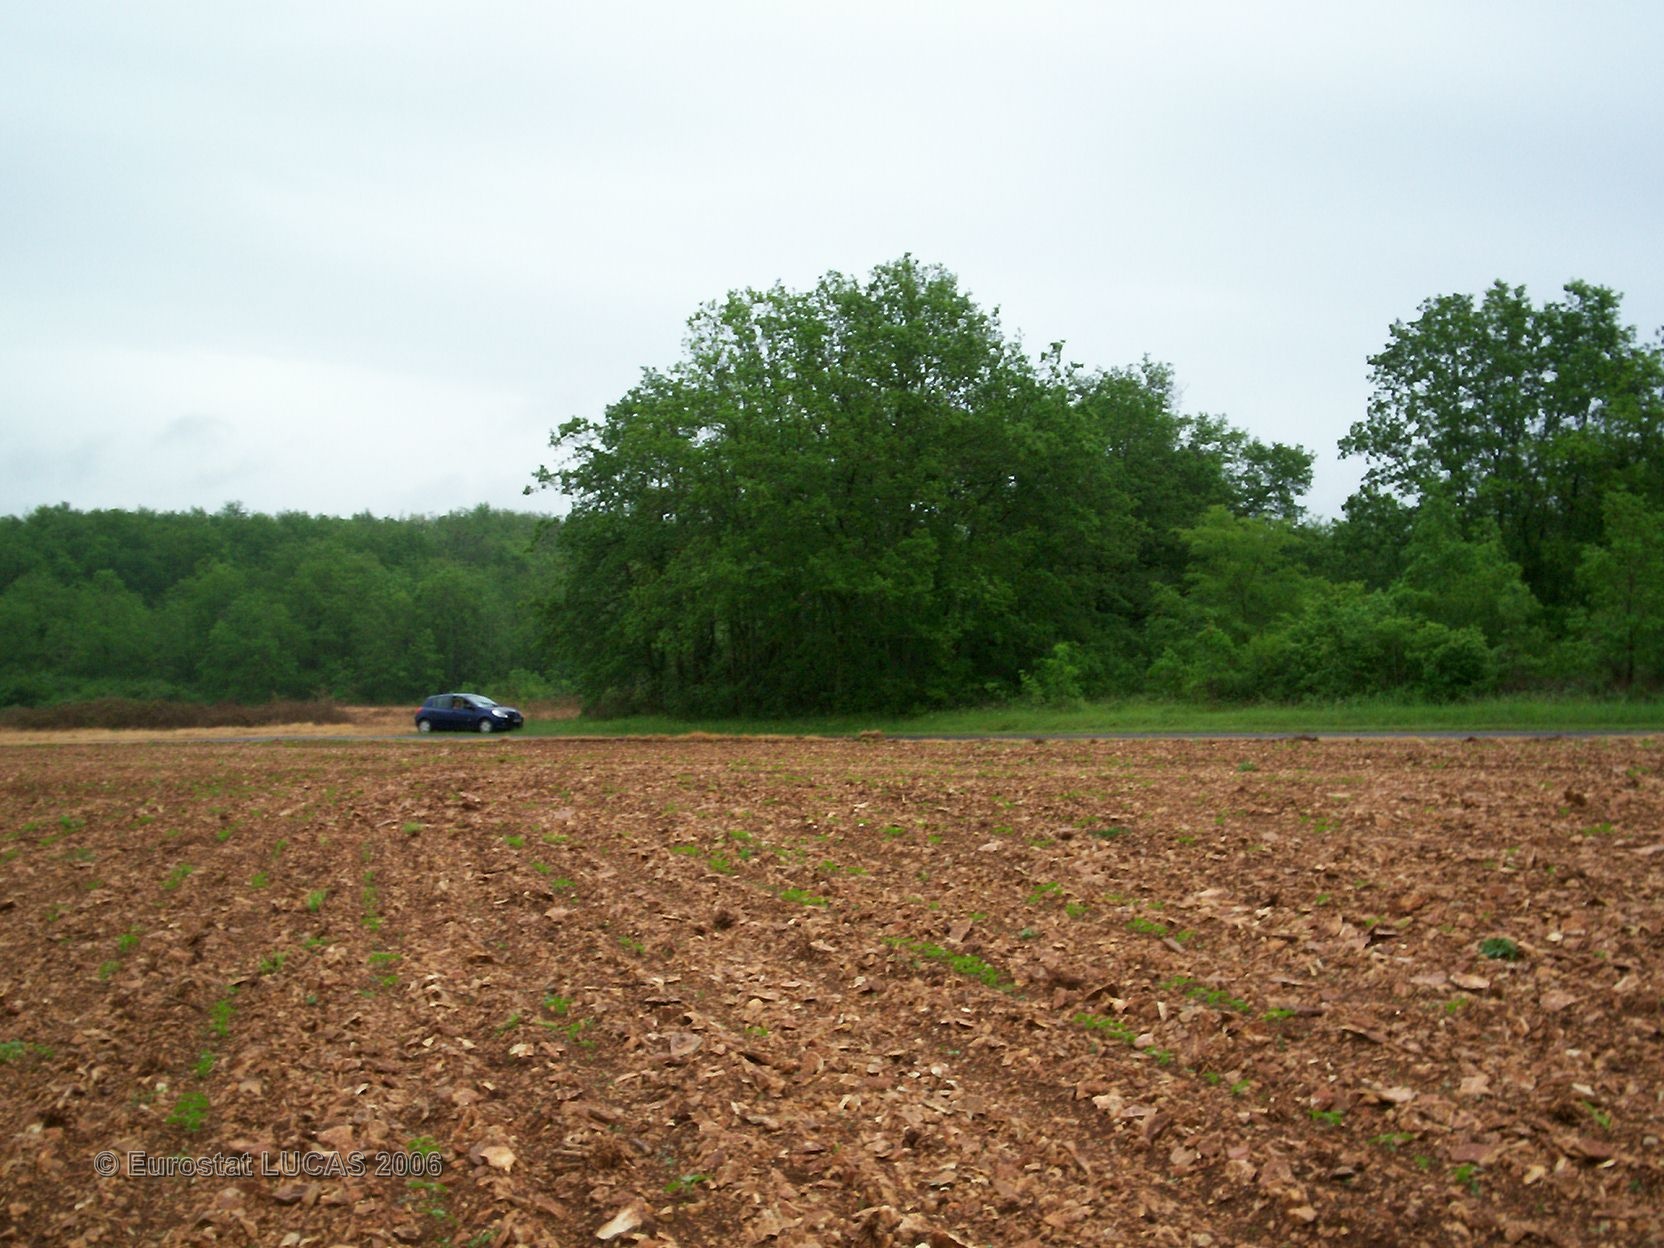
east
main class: Cropland
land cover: Sunflower
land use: Agriculture (excluding fallow land and kitchen gardens)
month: May
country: FR
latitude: 45.6558
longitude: 0.5027
